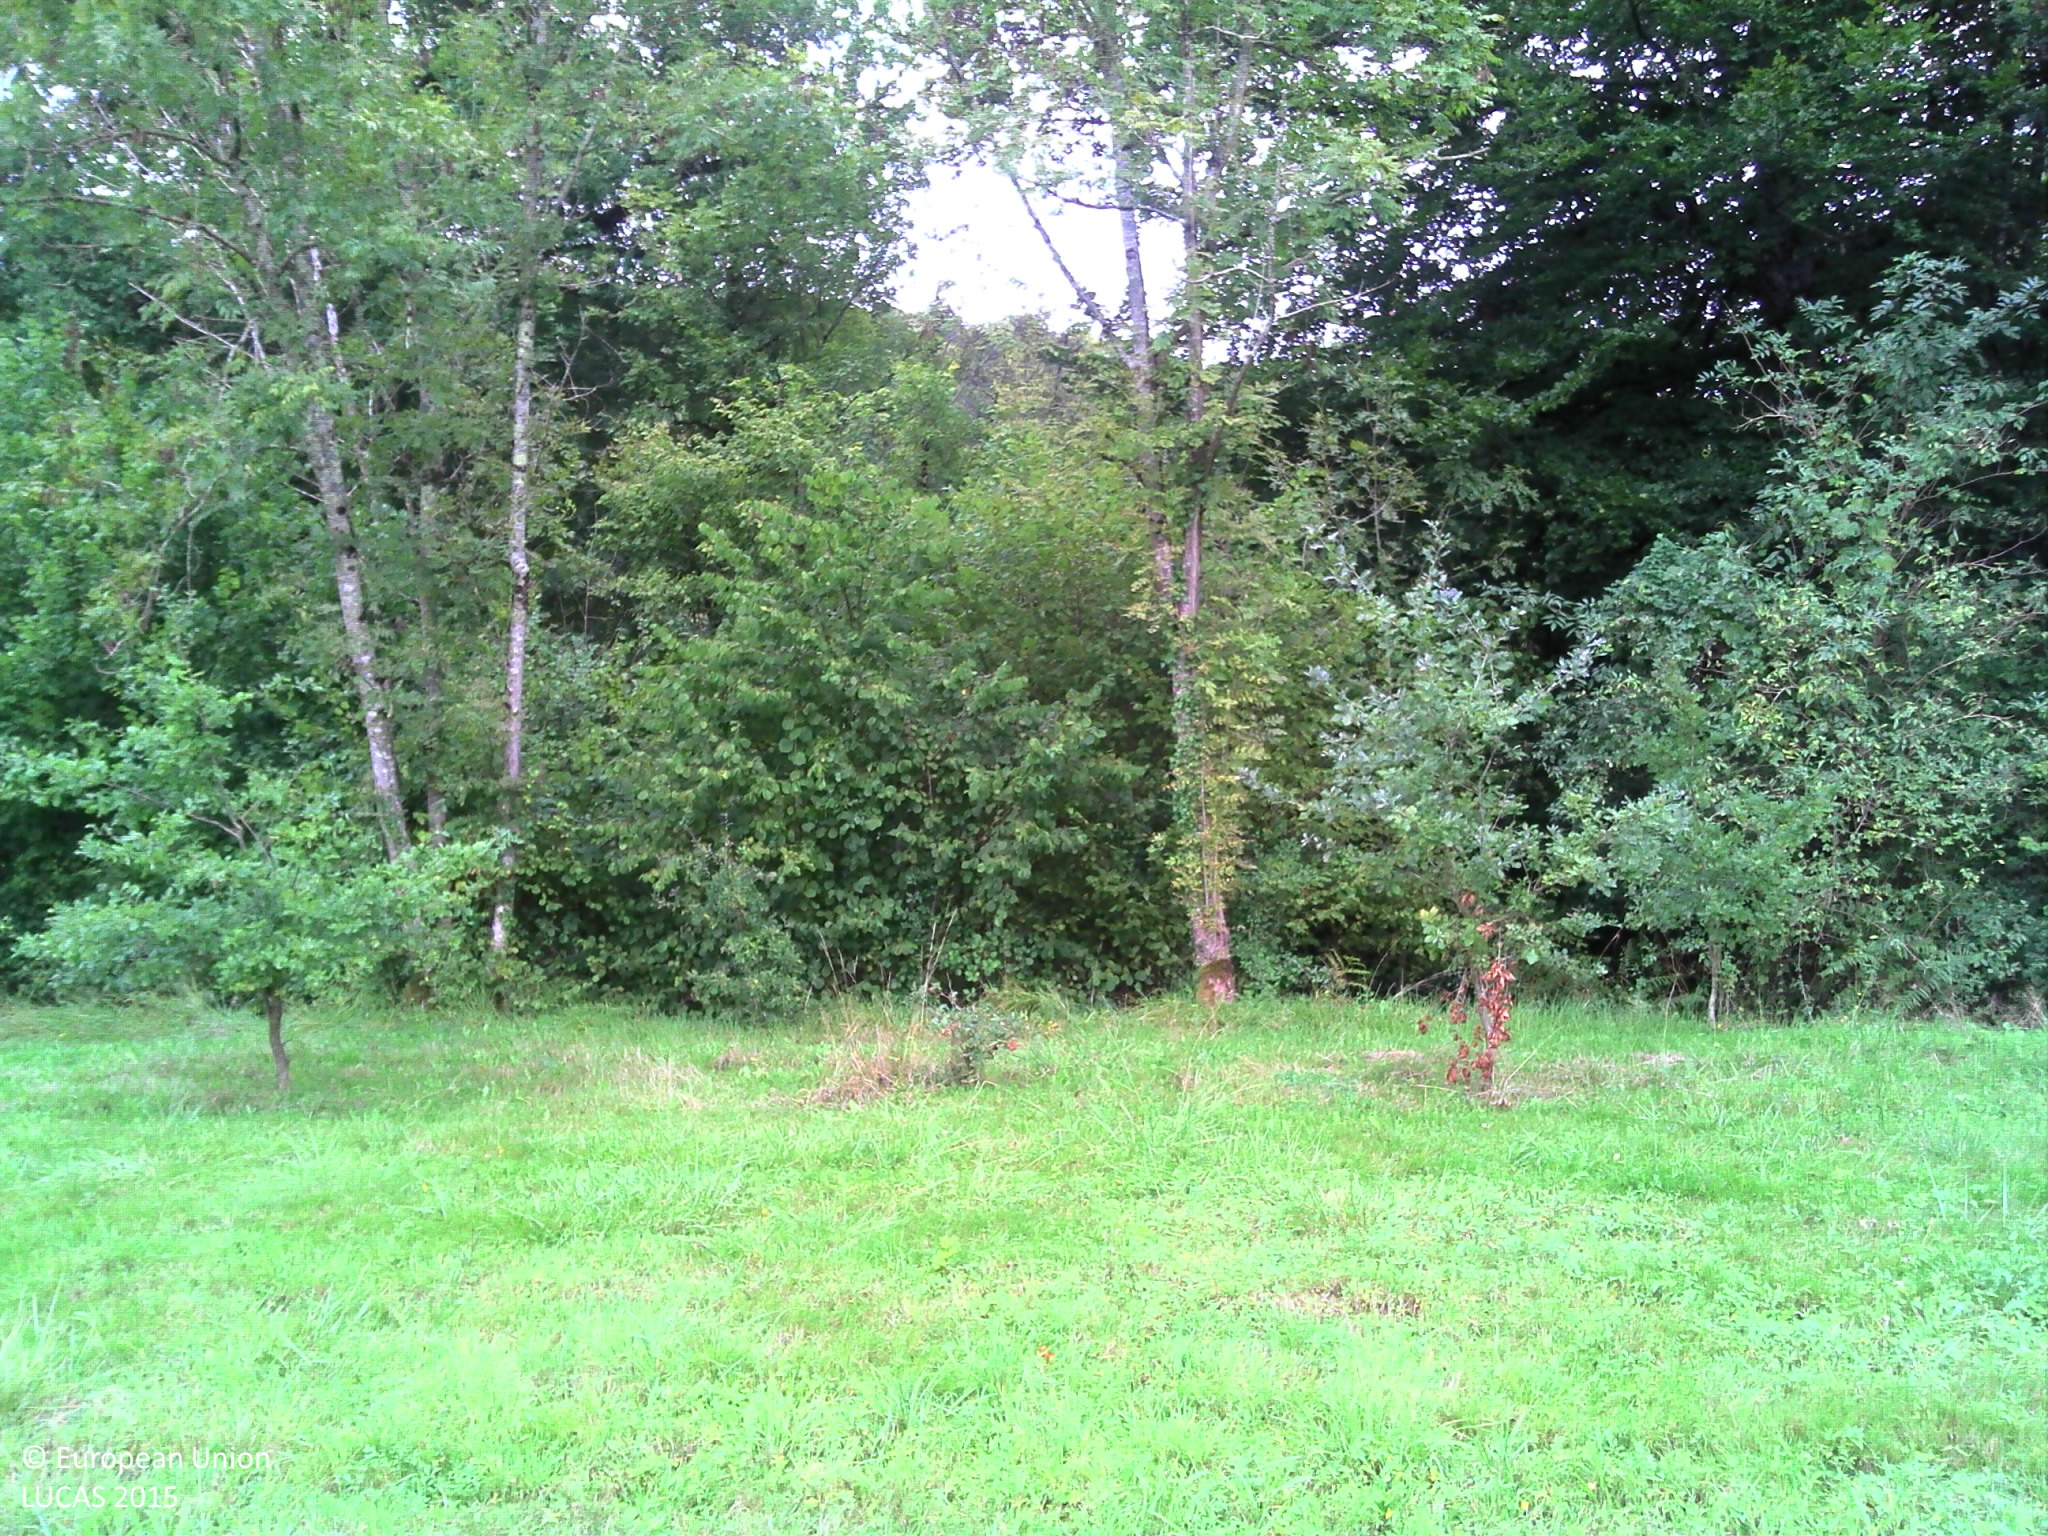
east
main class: Grassland
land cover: Grassland without tree/shrub cover
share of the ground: > 75 %
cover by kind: herbaceous plants 100 %
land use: Agriculture (excluding fallow land and kitchen gardens)
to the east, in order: Grassland without tree/shrub cover; Broadleaved woodland; Inland fresh running water; Broadleaved woodland; Grassland without tree/shrub cover; Electric lines; Grassland without tree/shrub cover; Fences; Broadleaved woodland
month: September
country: FR
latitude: 43.3100
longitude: -0.4749
